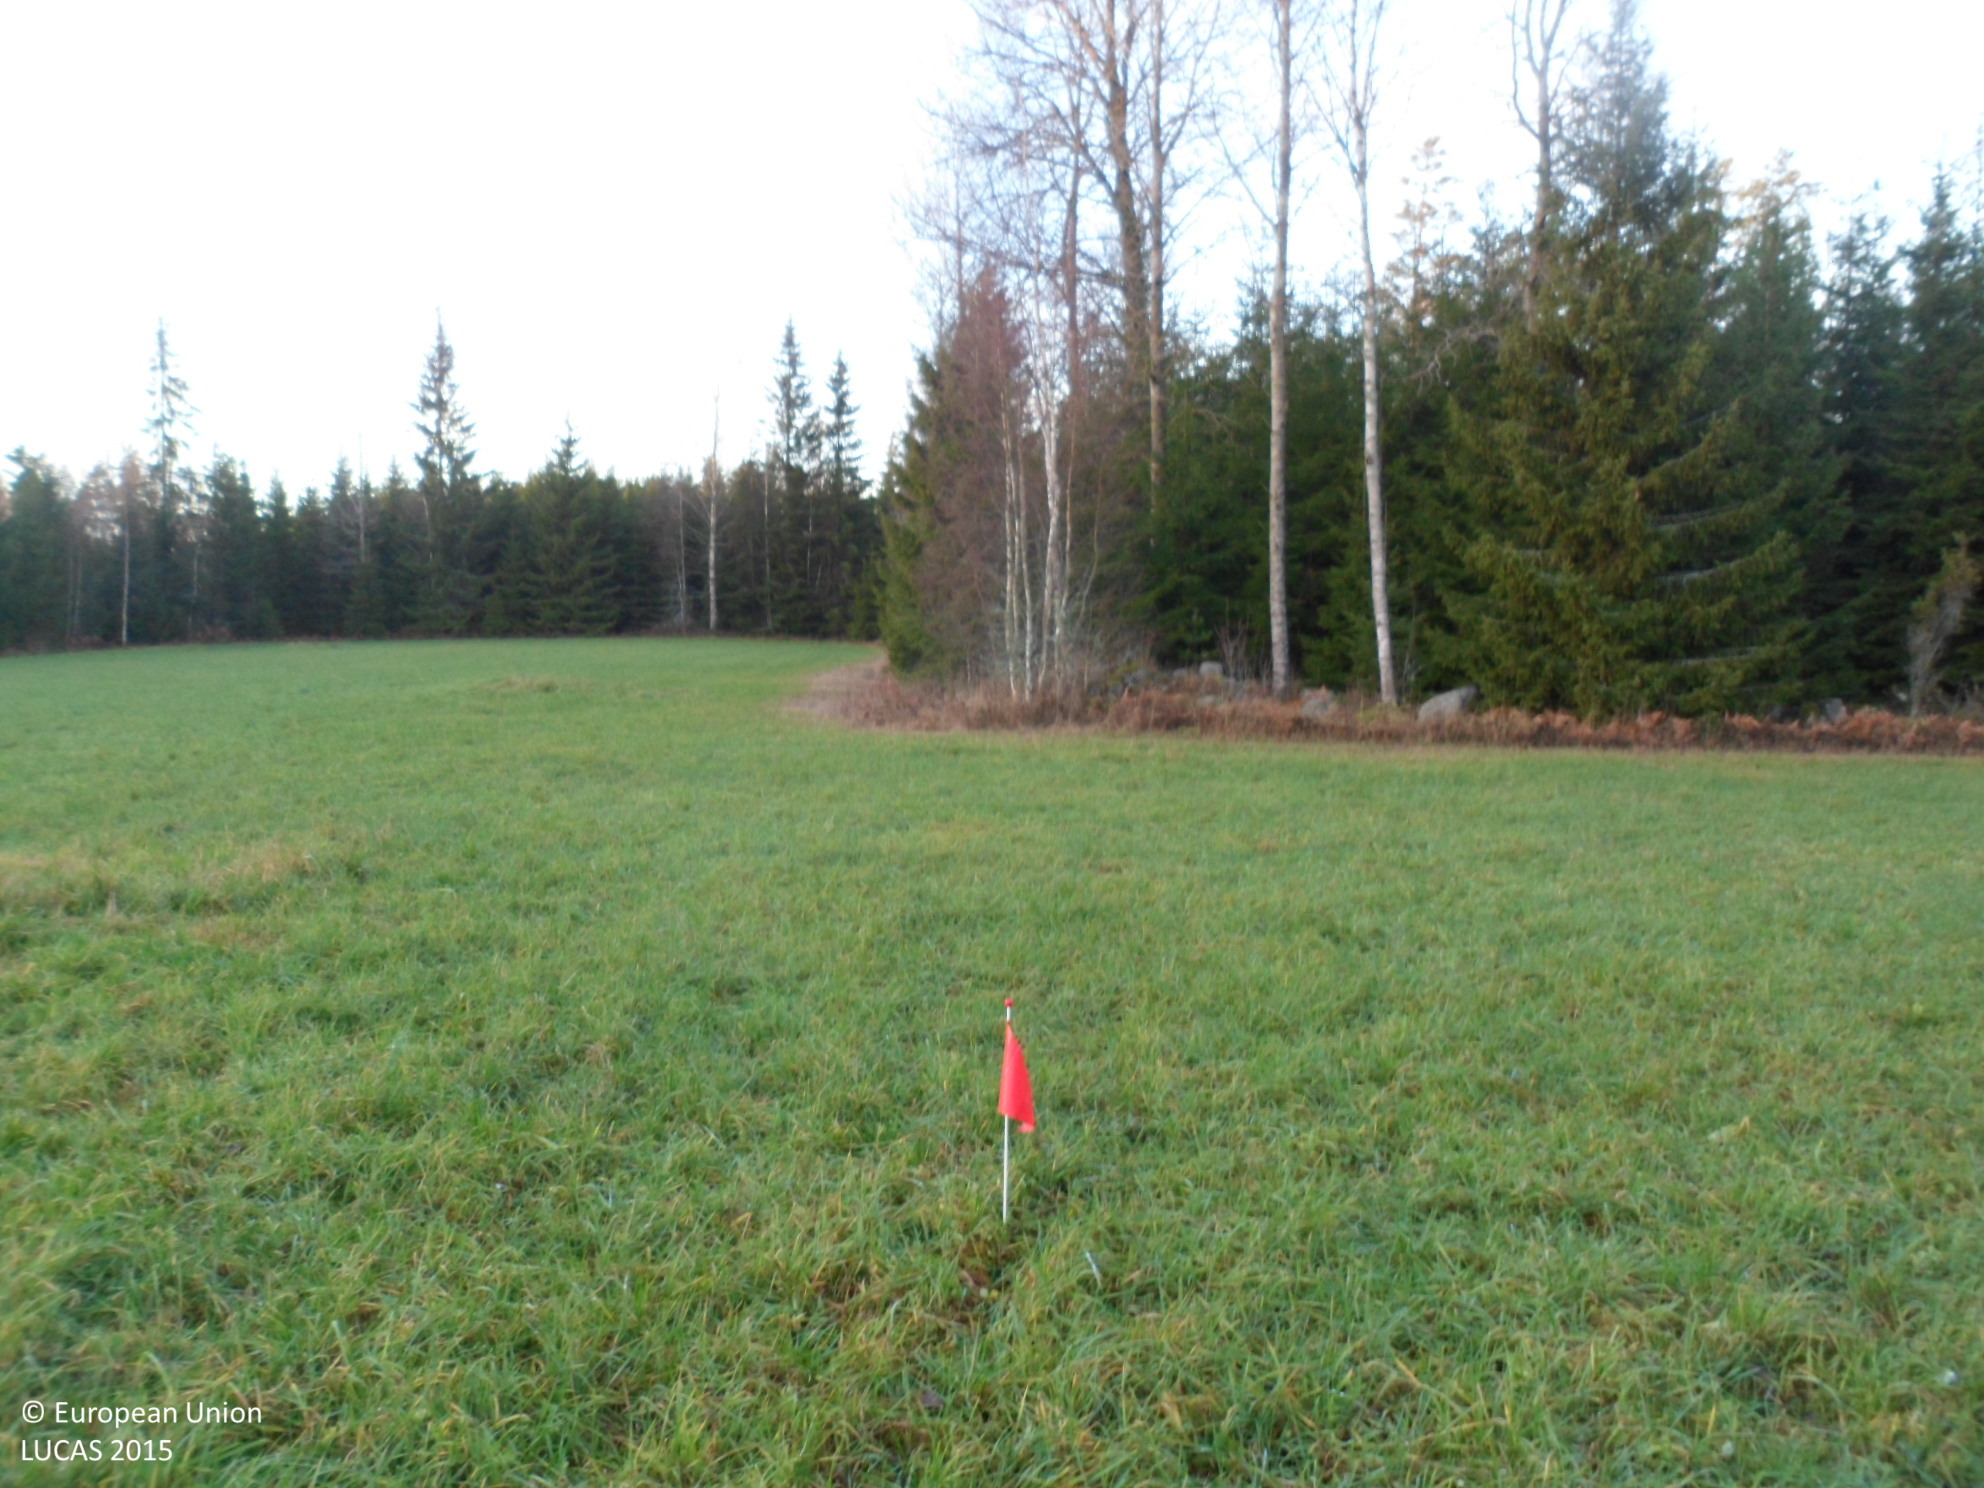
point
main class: Grassland
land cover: Grassland without tree/shrub cover
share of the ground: > 75 %
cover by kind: herbaceous plants 100 %
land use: Agriculture (excluding fallow land and kitchen gardens)
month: November
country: SE
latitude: 57.6334
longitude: 15.1712
